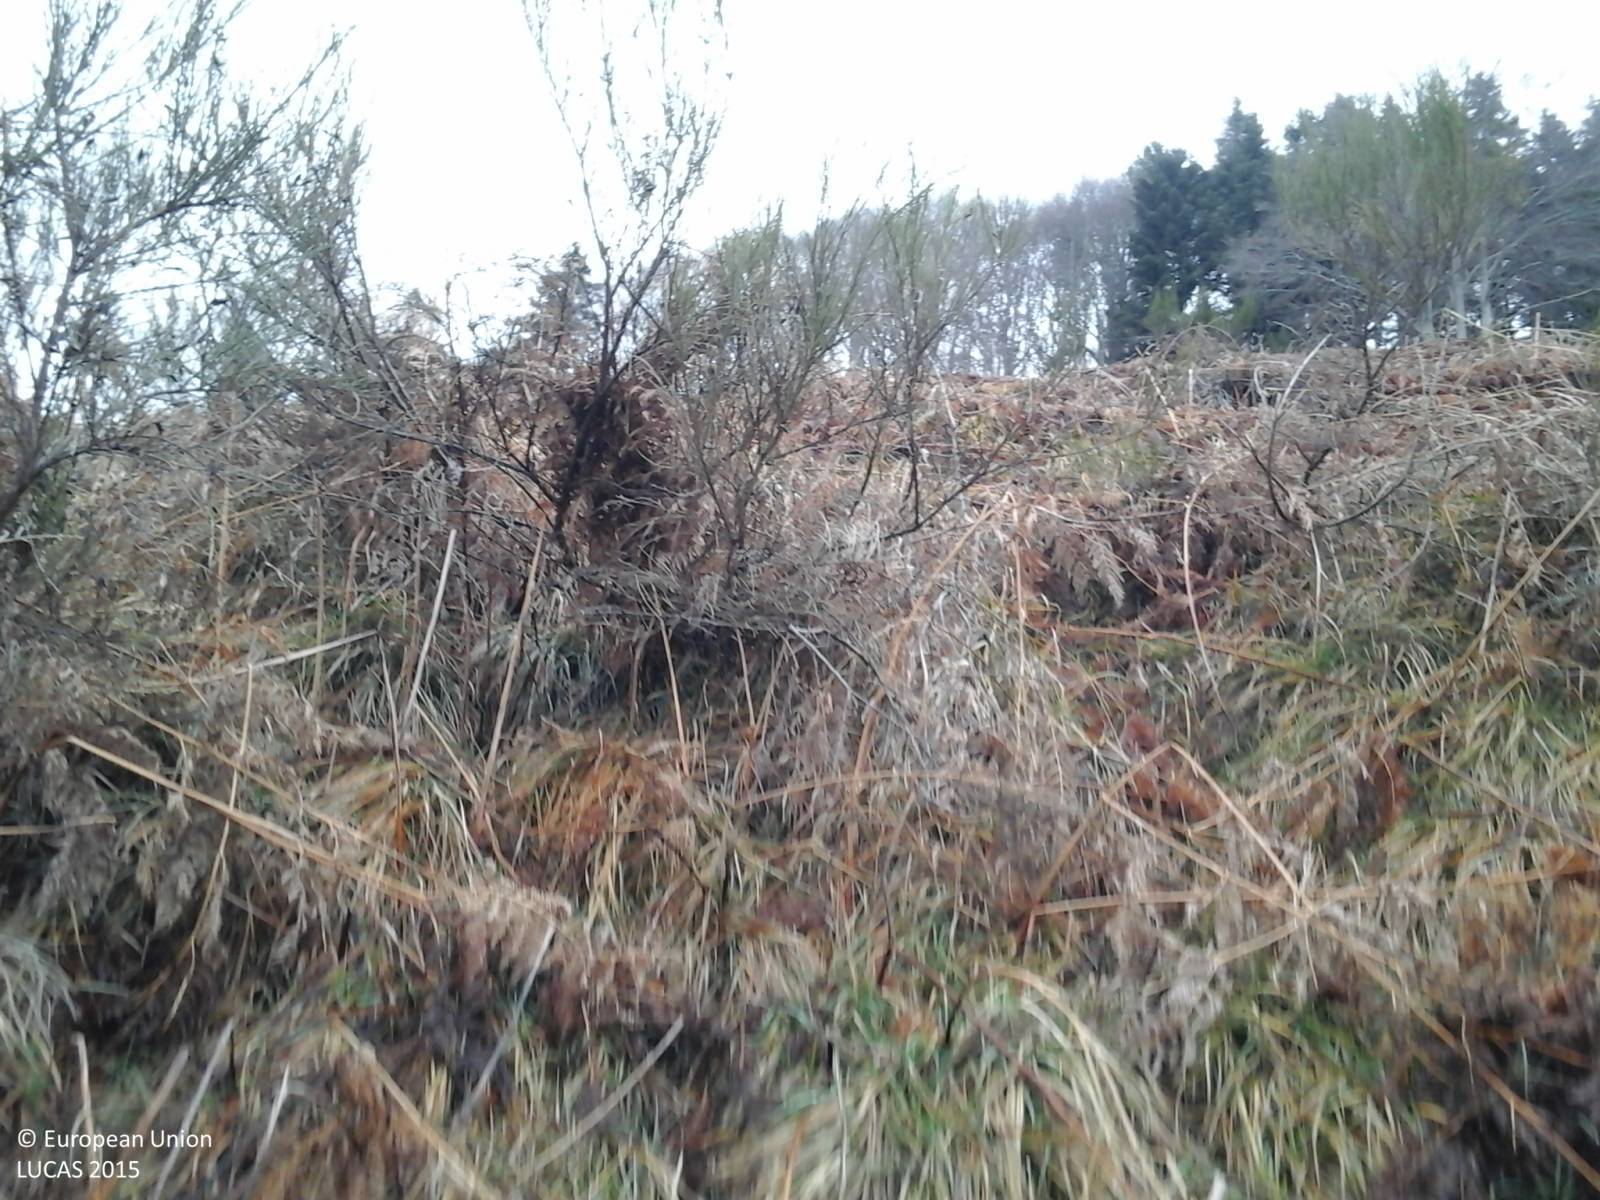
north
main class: Shrubland
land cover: Shrubland with sparse tree cover
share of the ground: > 75 %
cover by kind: shrubs 90 %, broadleaved forest trees 5 %, herbaceous plants 5 %
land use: Semi-natural and natural areas not in use
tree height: < 5 m
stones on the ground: 25 - 50 %
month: January
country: IT
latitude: 44.0962
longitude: 10.6106
